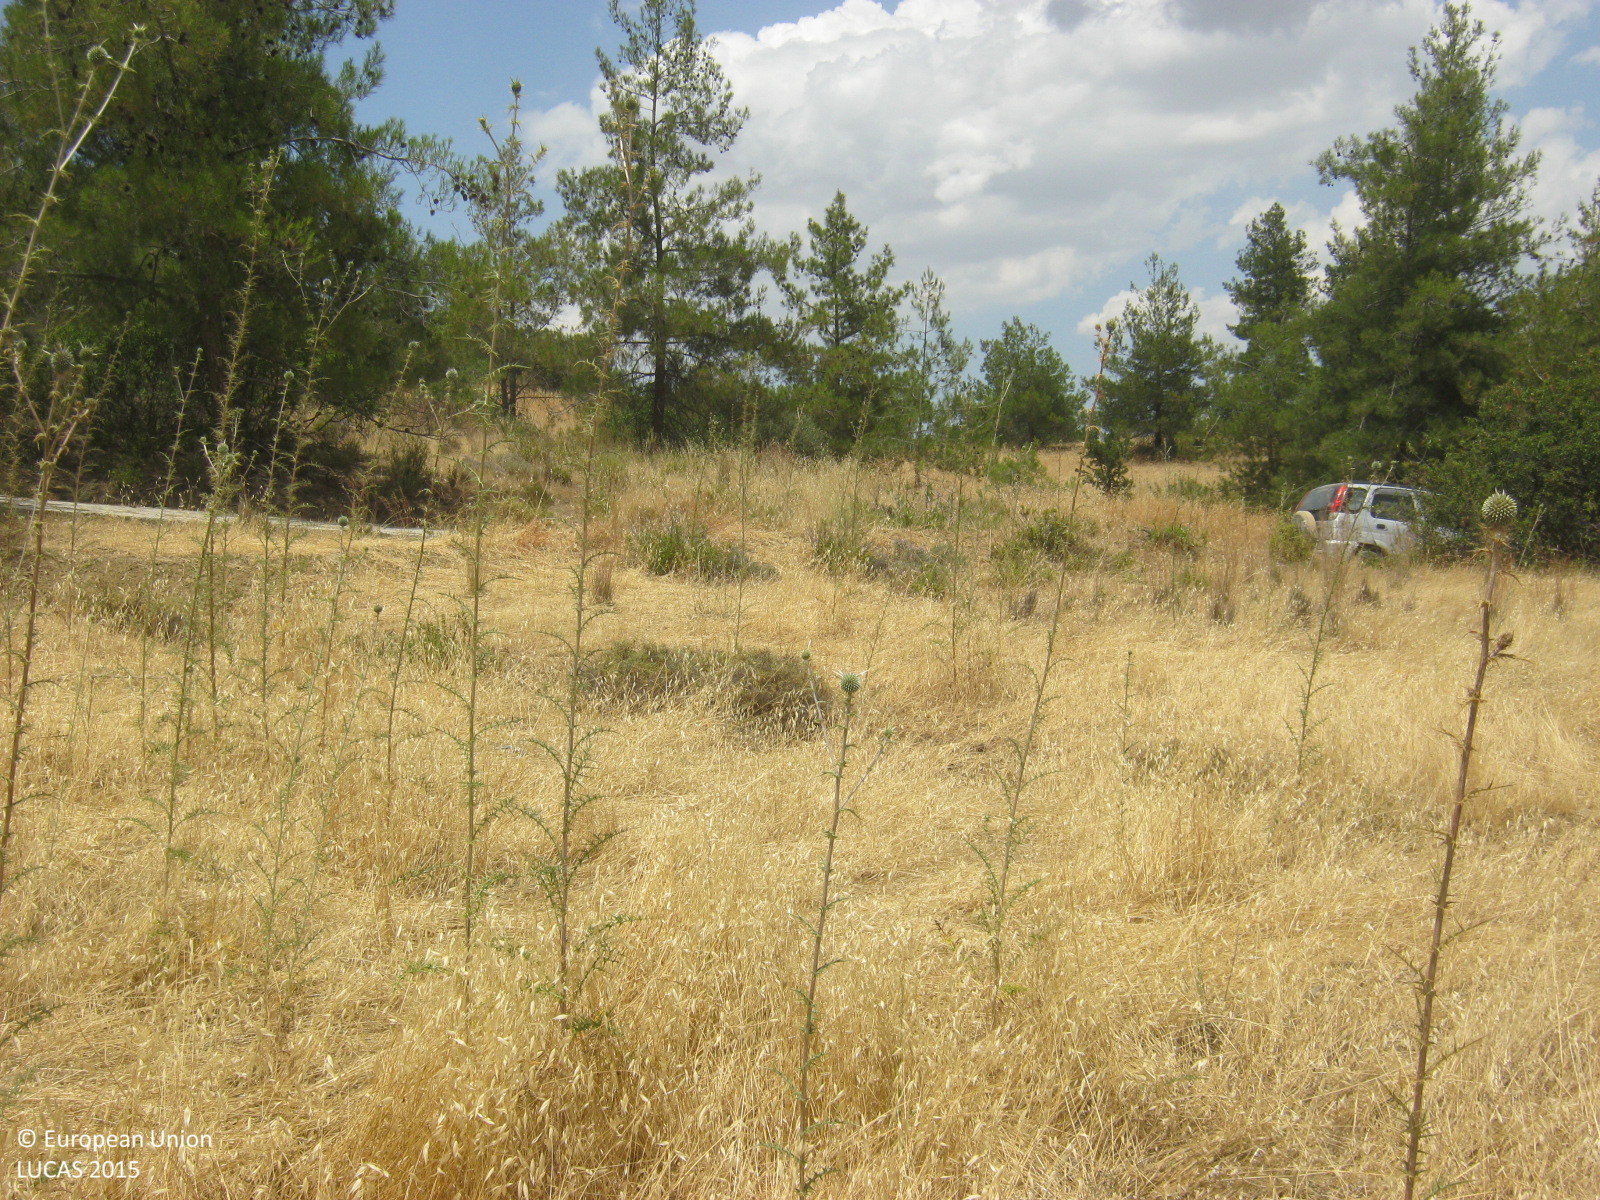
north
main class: Grassland
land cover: Grassland with sparse tree/shrub cover
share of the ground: > 75 %
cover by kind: herbaceous plants 90 %, coniferous forest trees 5 %, shrubs 5 %
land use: Semi-natural and natural areas not in use
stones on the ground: 10 - 25 %
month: June
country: CY
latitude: 34.9871
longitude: 33.1978
